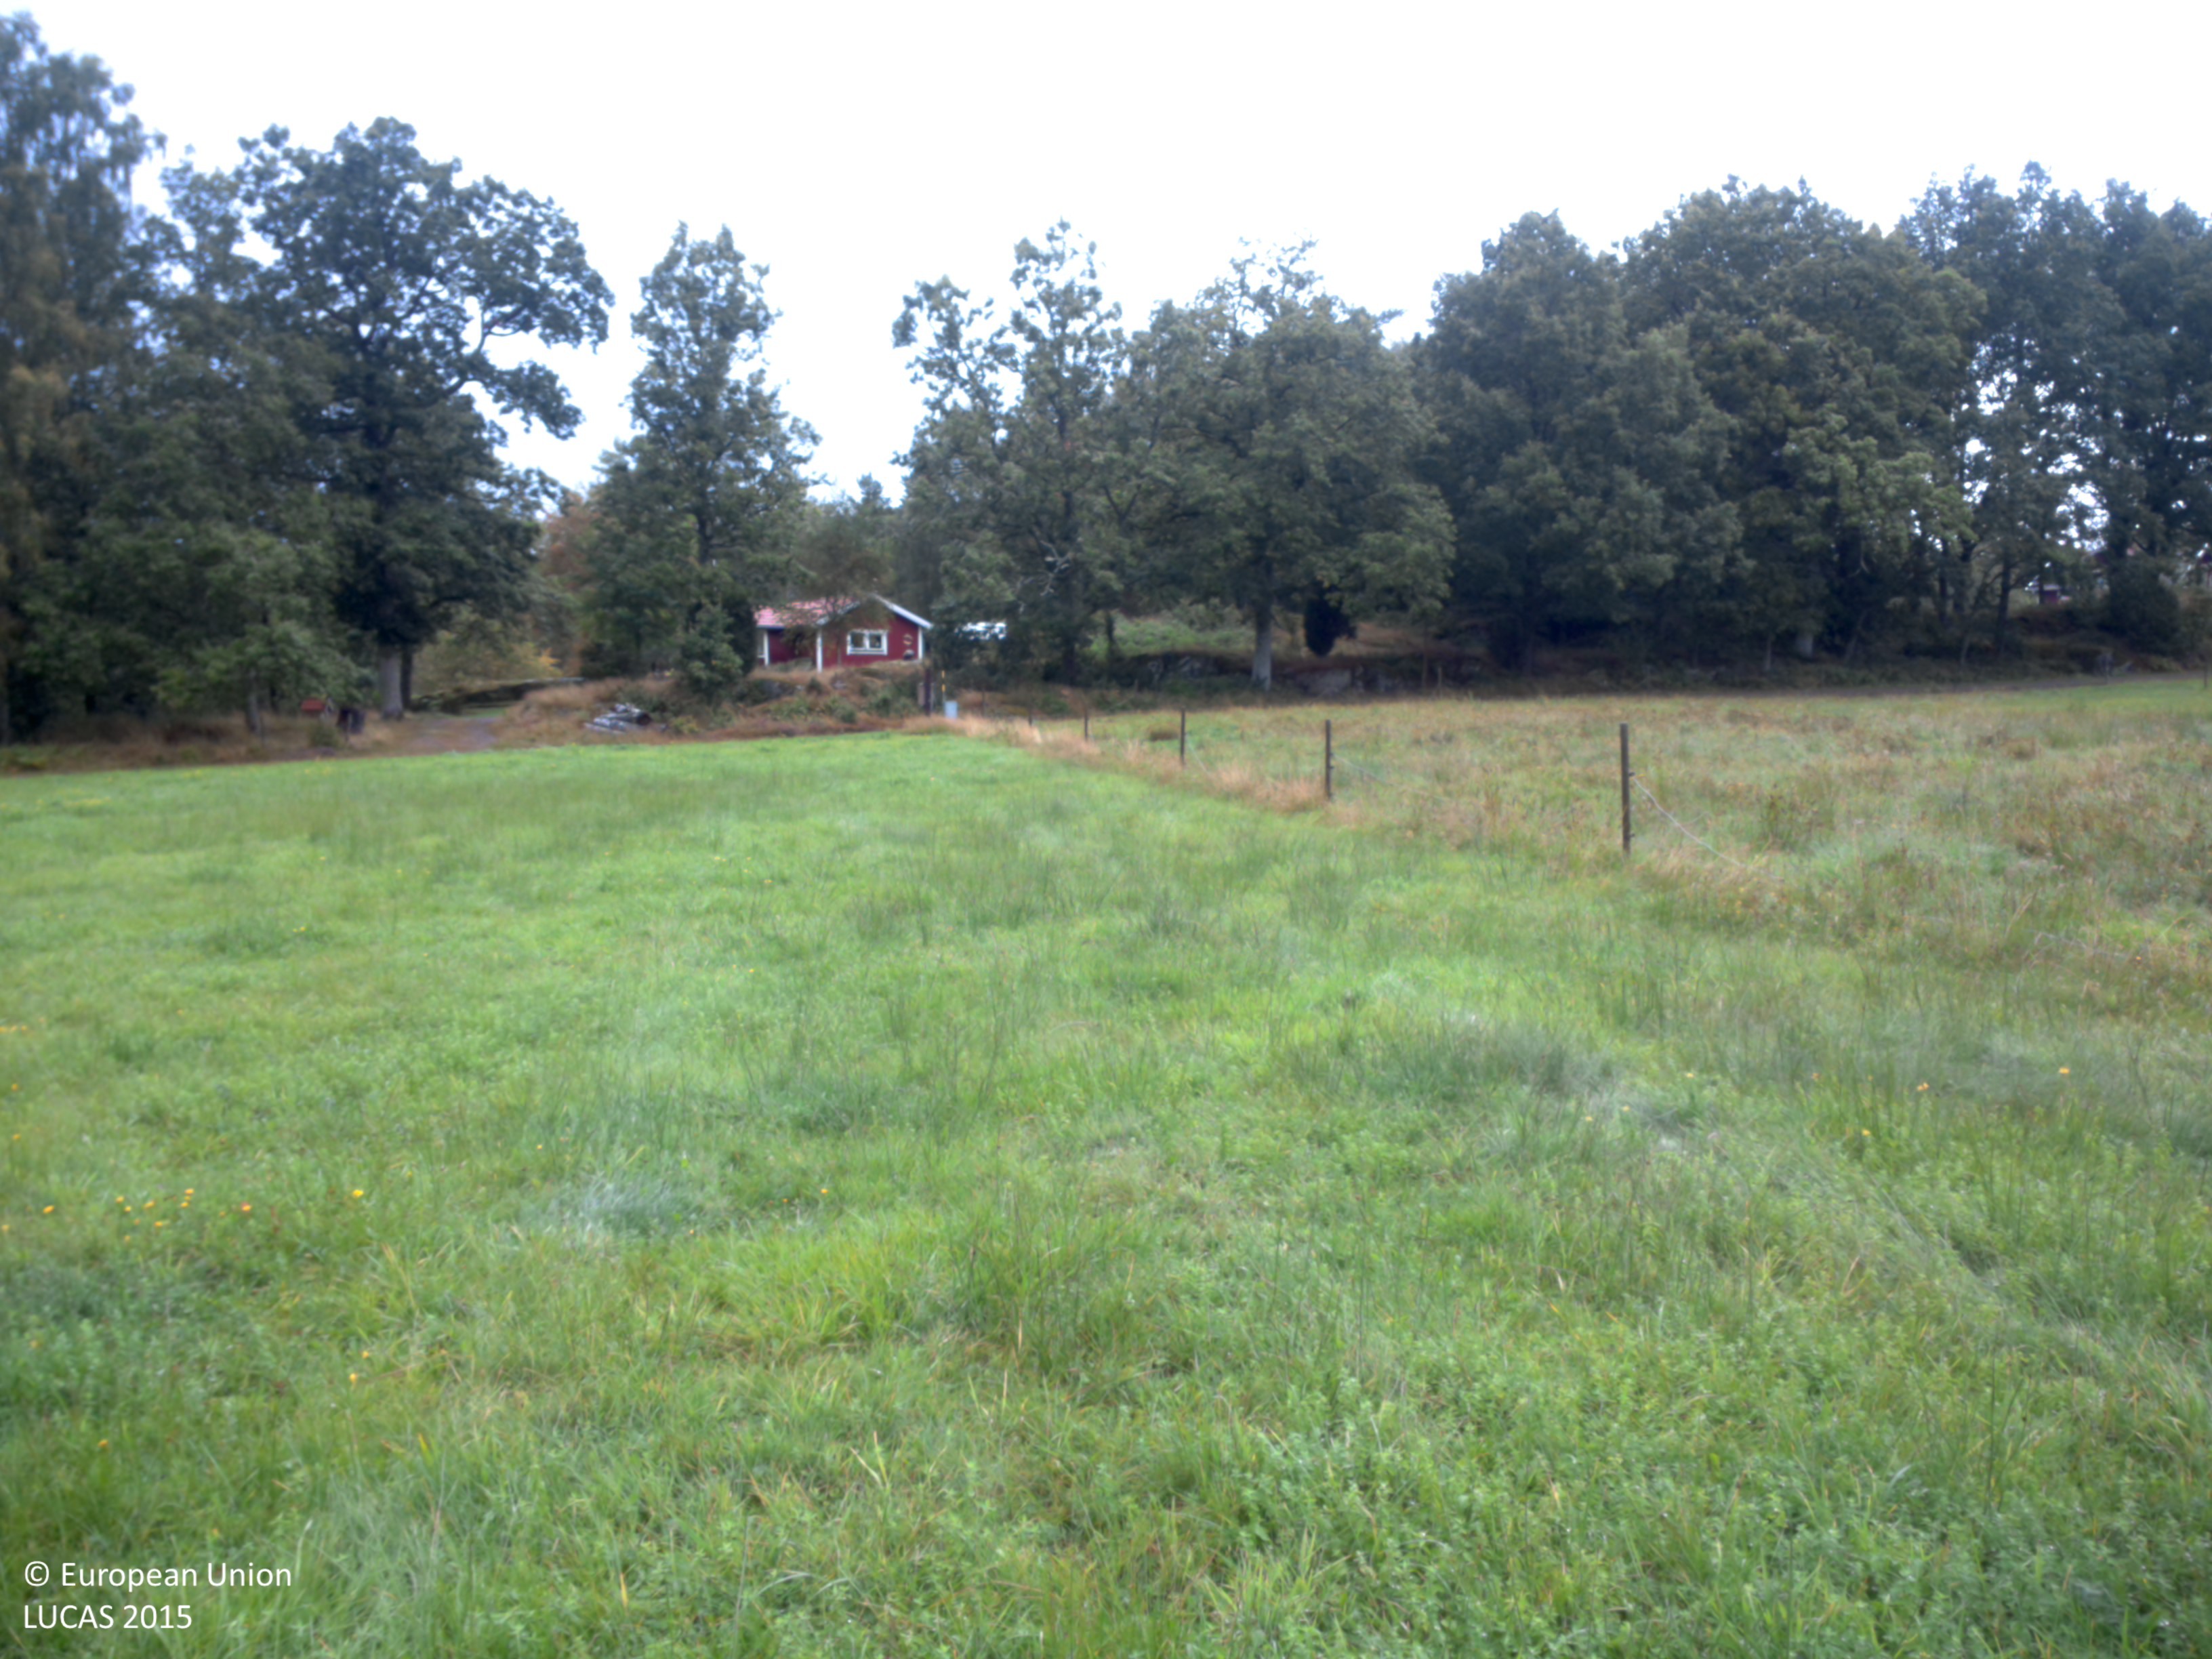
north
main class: Grassland
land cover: Grassland without tree/shrub cover
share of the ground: > 75 %
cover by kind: herbaceous plants 100 %
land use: Agriculture (excluding fallow land and kitchen gardens)
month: August
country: SE
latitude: 58.1095
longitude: 12.3208
